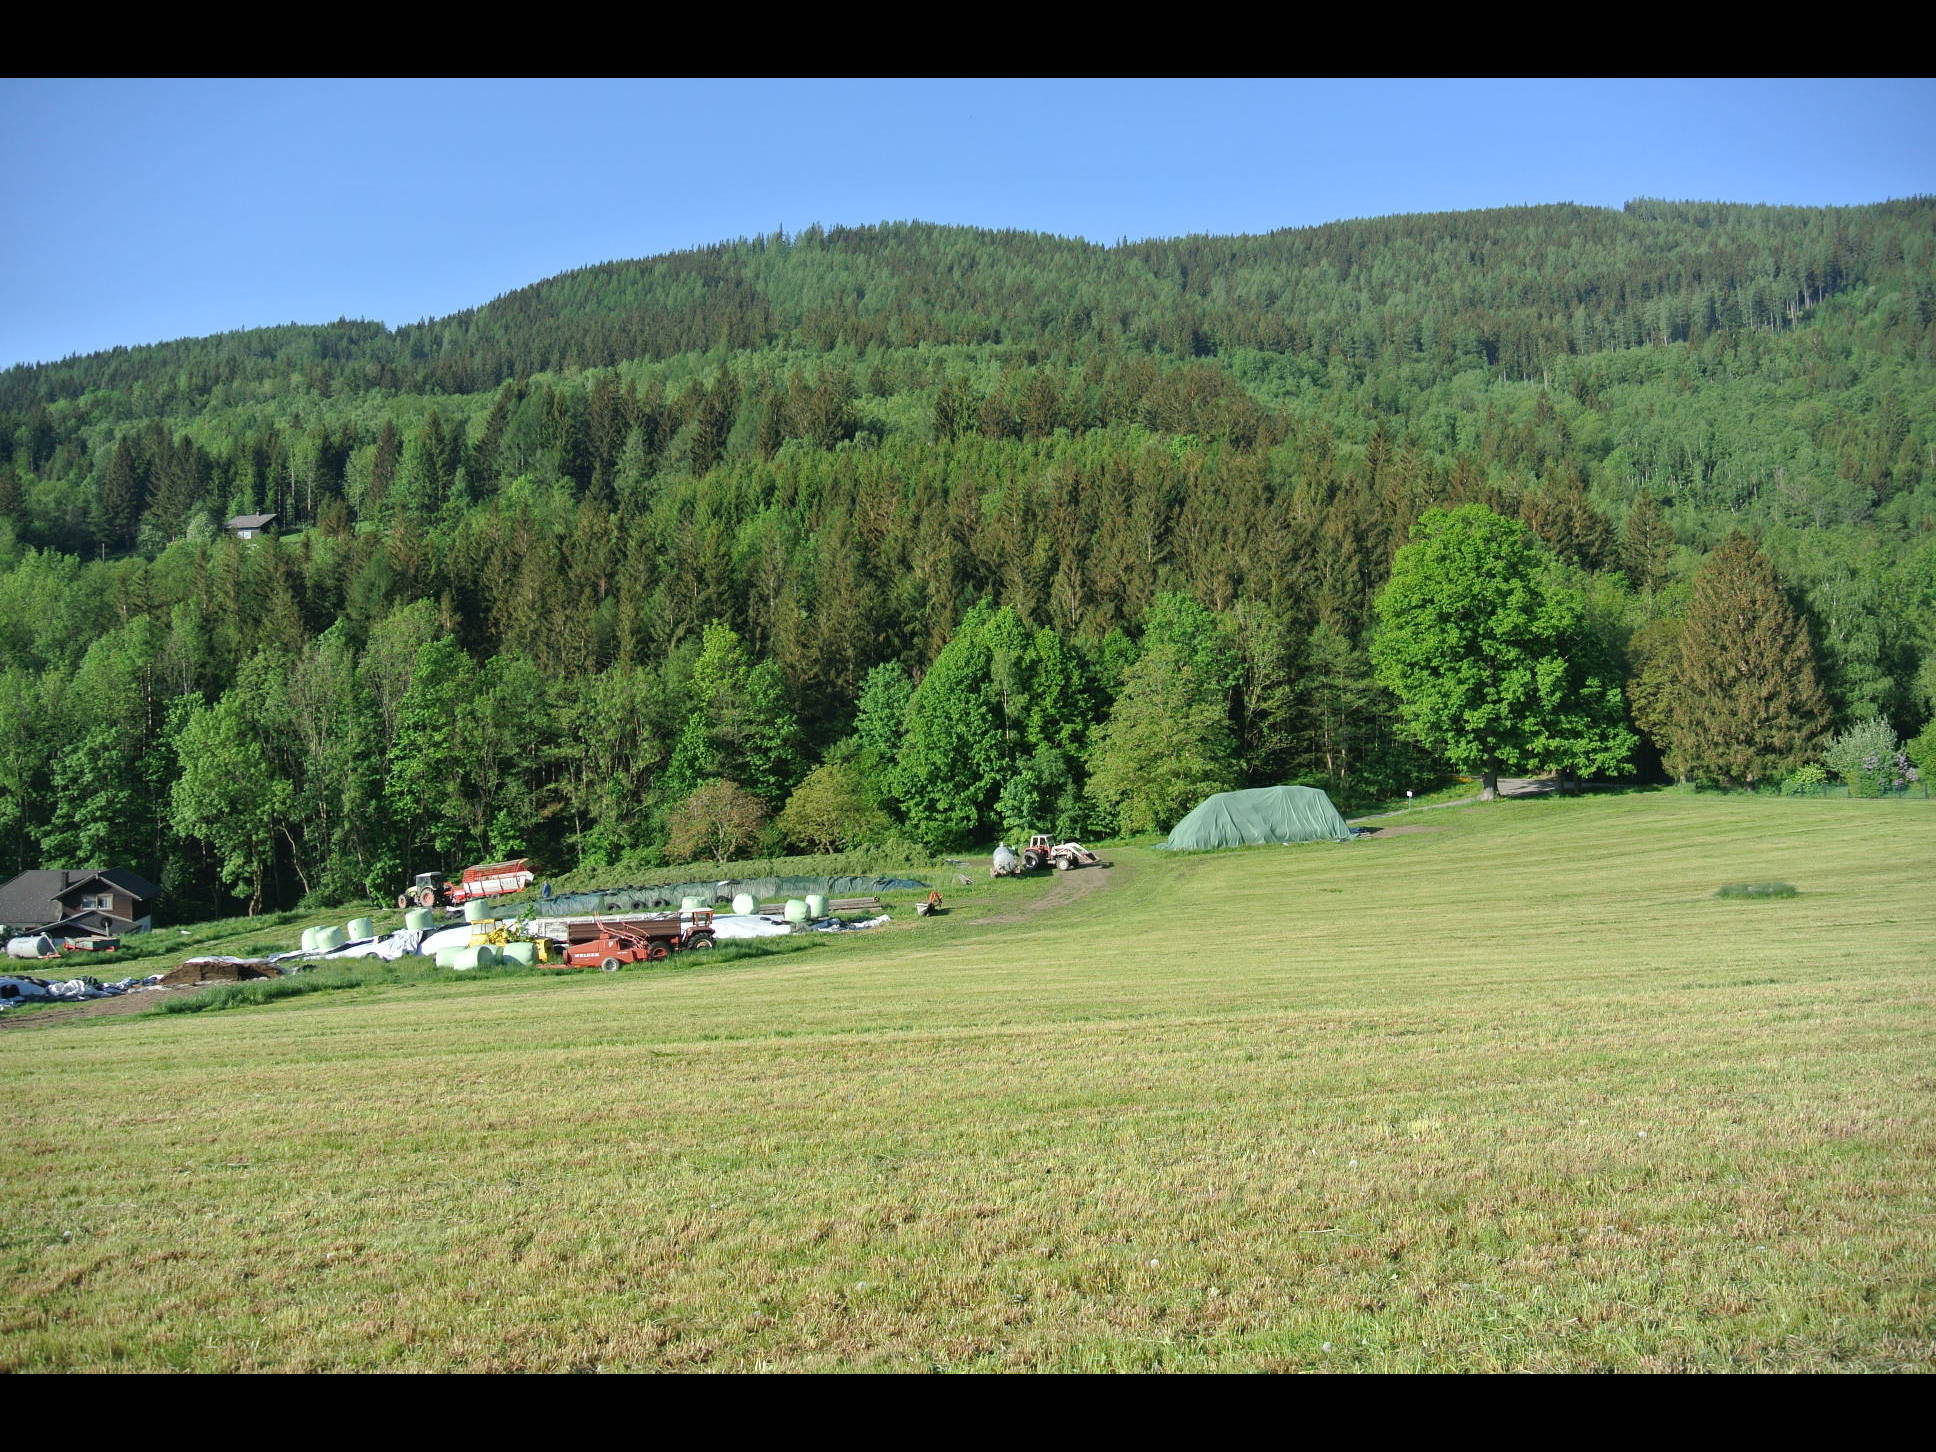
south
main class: Cropland
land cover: Temporary grasslands
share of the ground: > 75 %
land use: Agriculture (excluding fallow land and kitchen gardens)
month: May
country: AT
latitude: 47.6935
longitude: 15.7713
